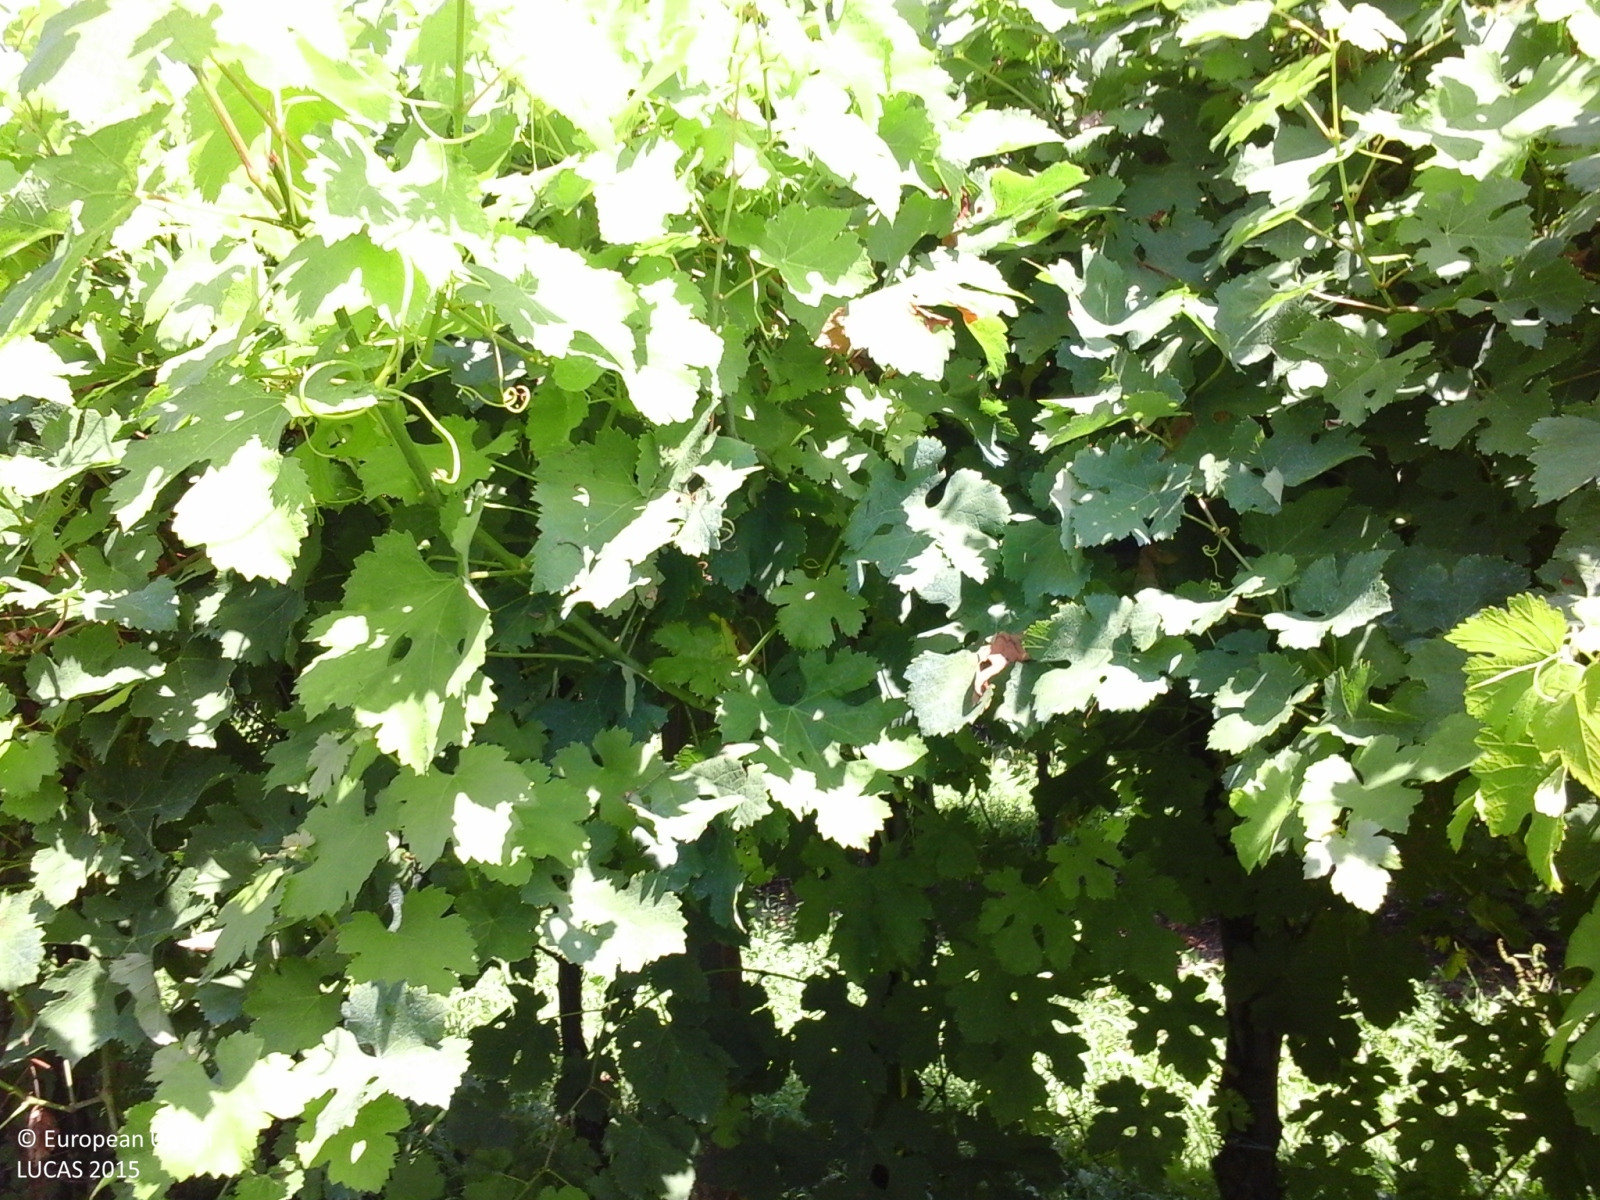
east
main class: Cropland
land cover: Vineyards
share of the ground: 25 - 50 %
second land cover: Grassland without tree/shrub cover
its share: > 75 %
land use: Agriculture (excluding fallow land and kitchen gardens)
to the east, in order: Vineyards; Grassland without tree/shrub cover; Ditches and canals; Fences; Grass margins; Paved roads, cycling and walking lanes; Grass margins; Fences; Ditches and canals; Vineyards; Fences; Grassland without tree/shrub cover
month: July
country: IT
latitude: 45.8038
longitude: 12.3000
